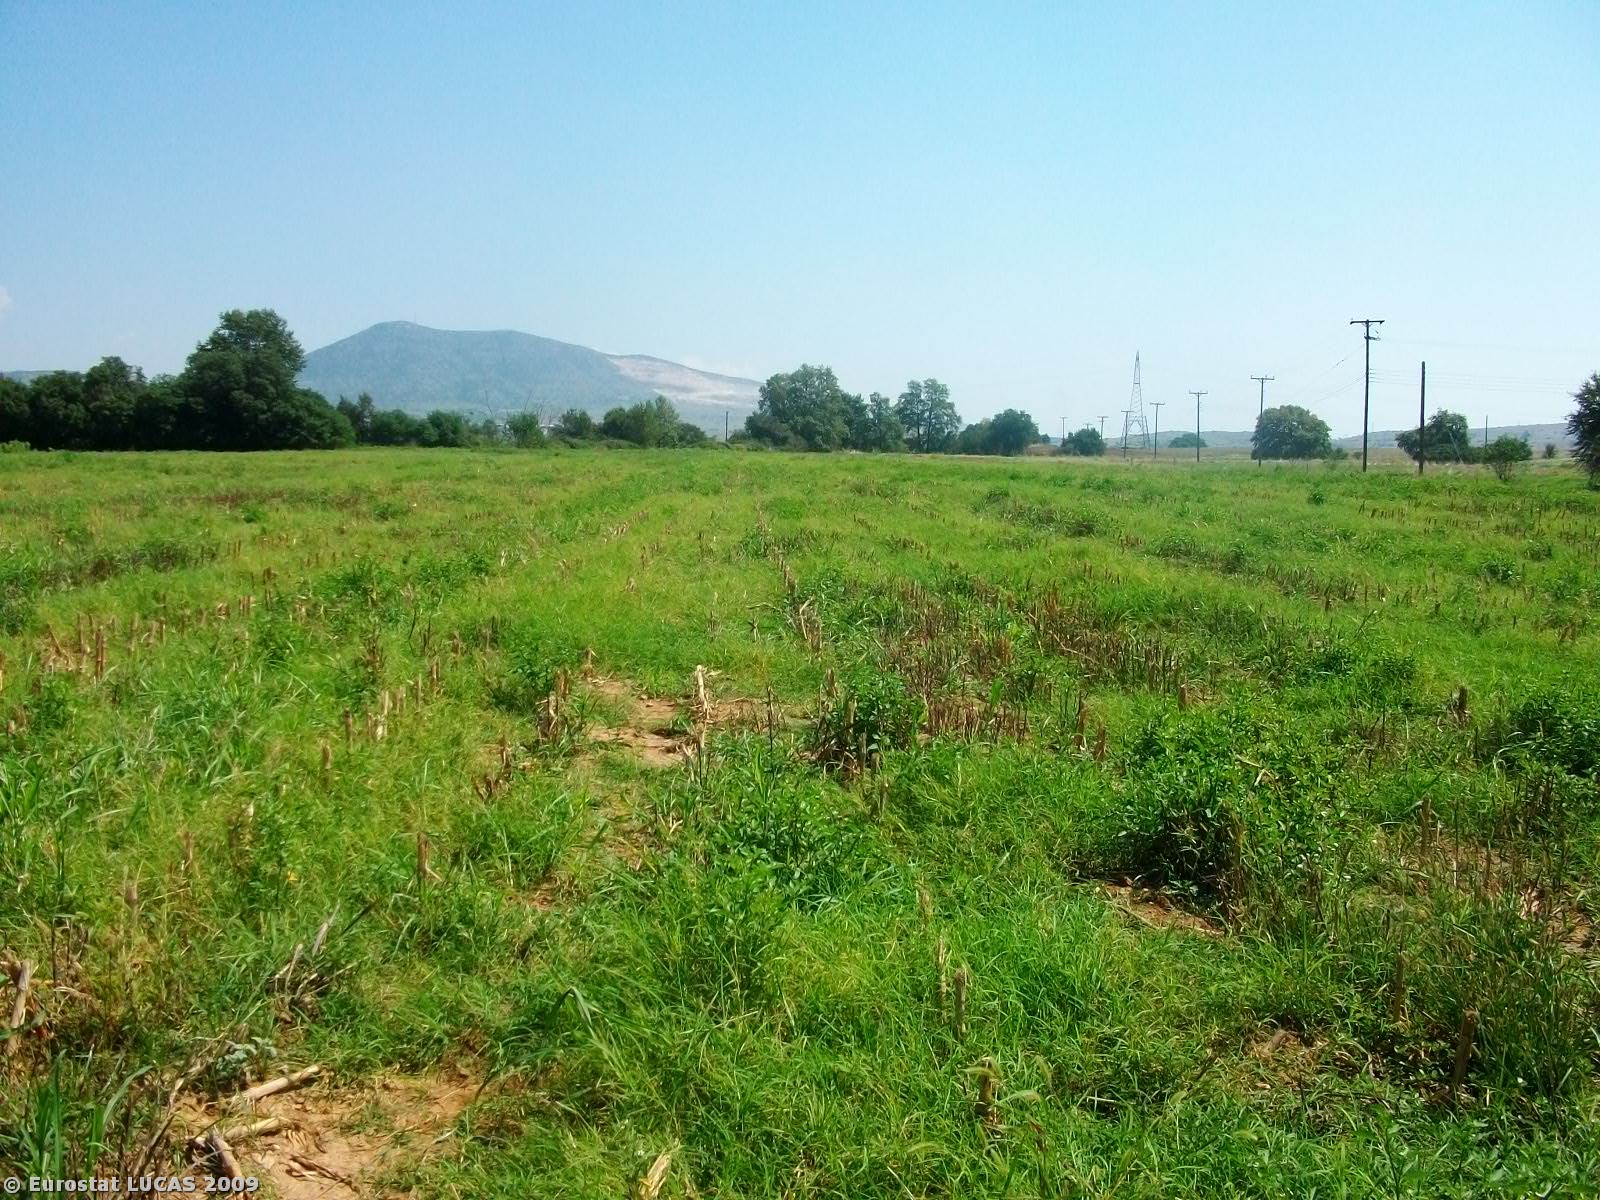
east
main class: Cropland
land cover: Maize
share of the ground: < 10 %
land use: Agriculture (excluding fallow land and kitchen gardens)
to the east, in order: Maize; Grass margins; Paved roads, cycling and walking lanes; Grass margins; Maize; Shrubland with sparse tree cover
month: August
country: GR
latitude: 40.8207
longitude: 22.8967
